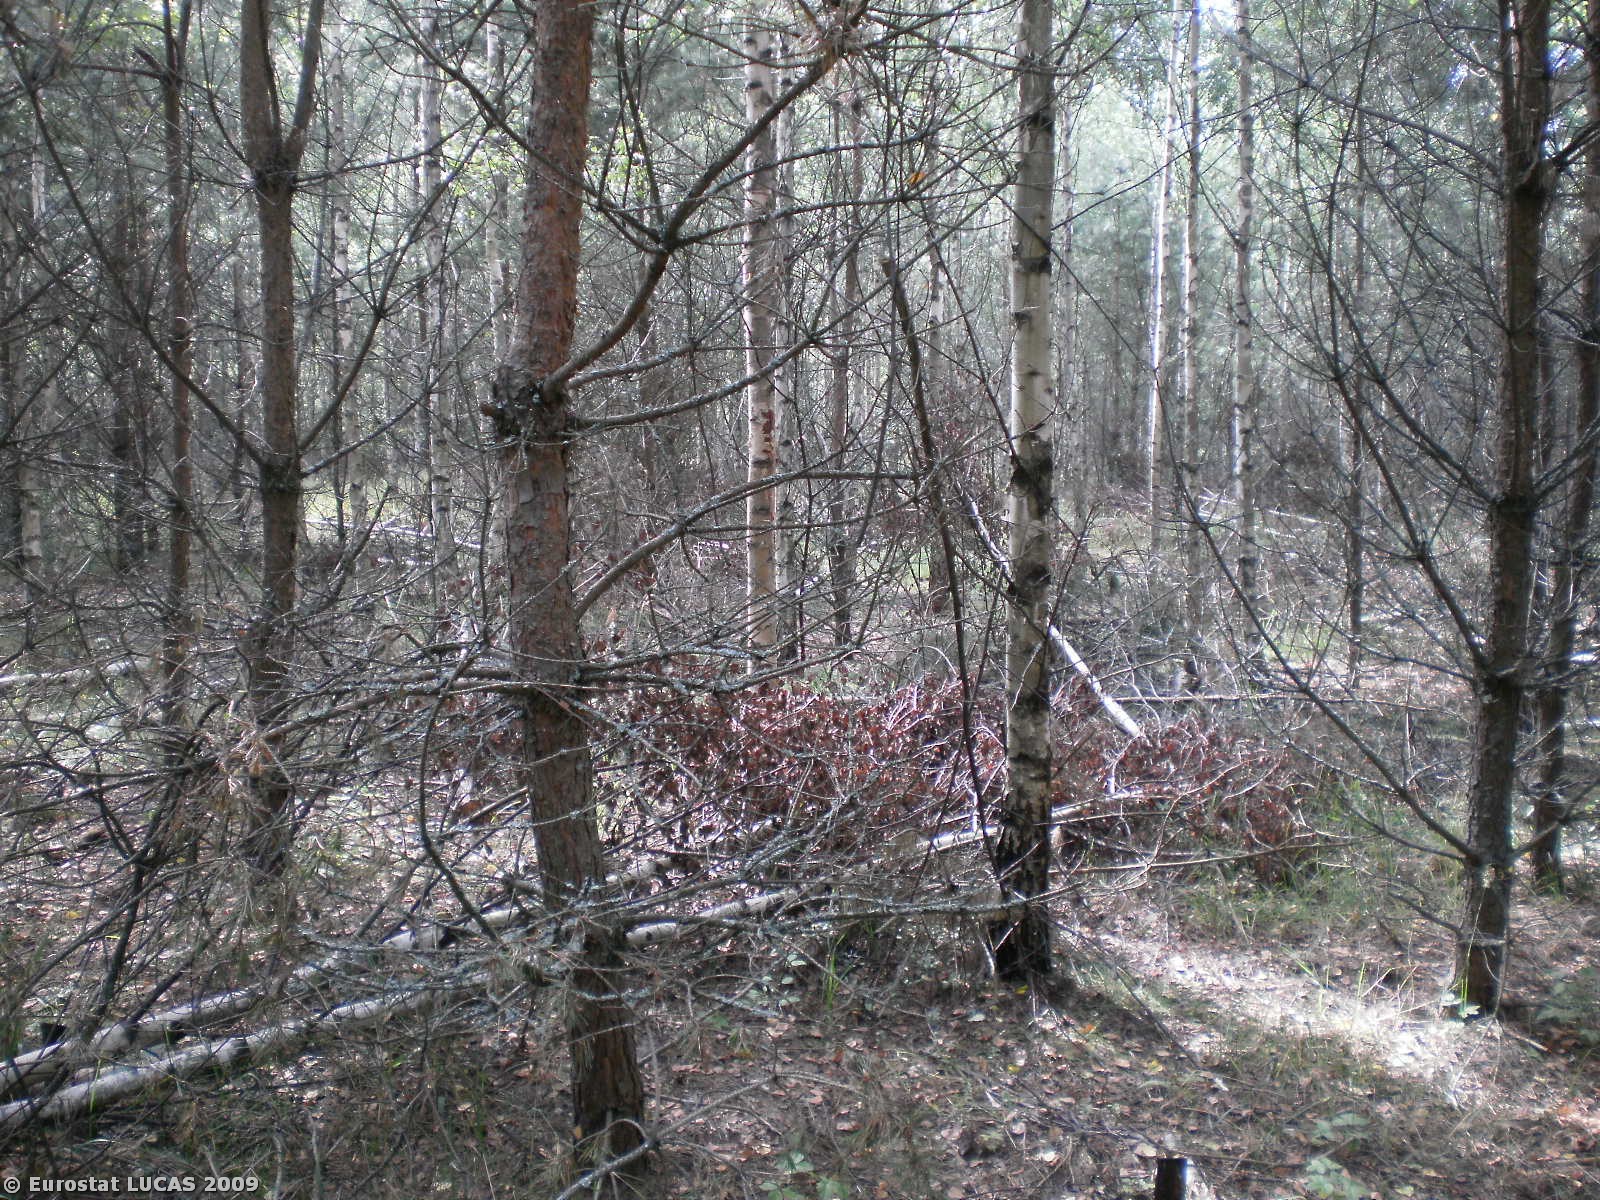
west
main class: Woodland
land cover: Mixed woodland
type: hemiboreal forest and nemoral coniferous forest and mixed broadleaved-coniferous forest
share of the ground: > 75 %
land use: Forestry
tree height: > 5 m
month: July
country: PL
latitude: 53.8117
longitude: 19.8866
